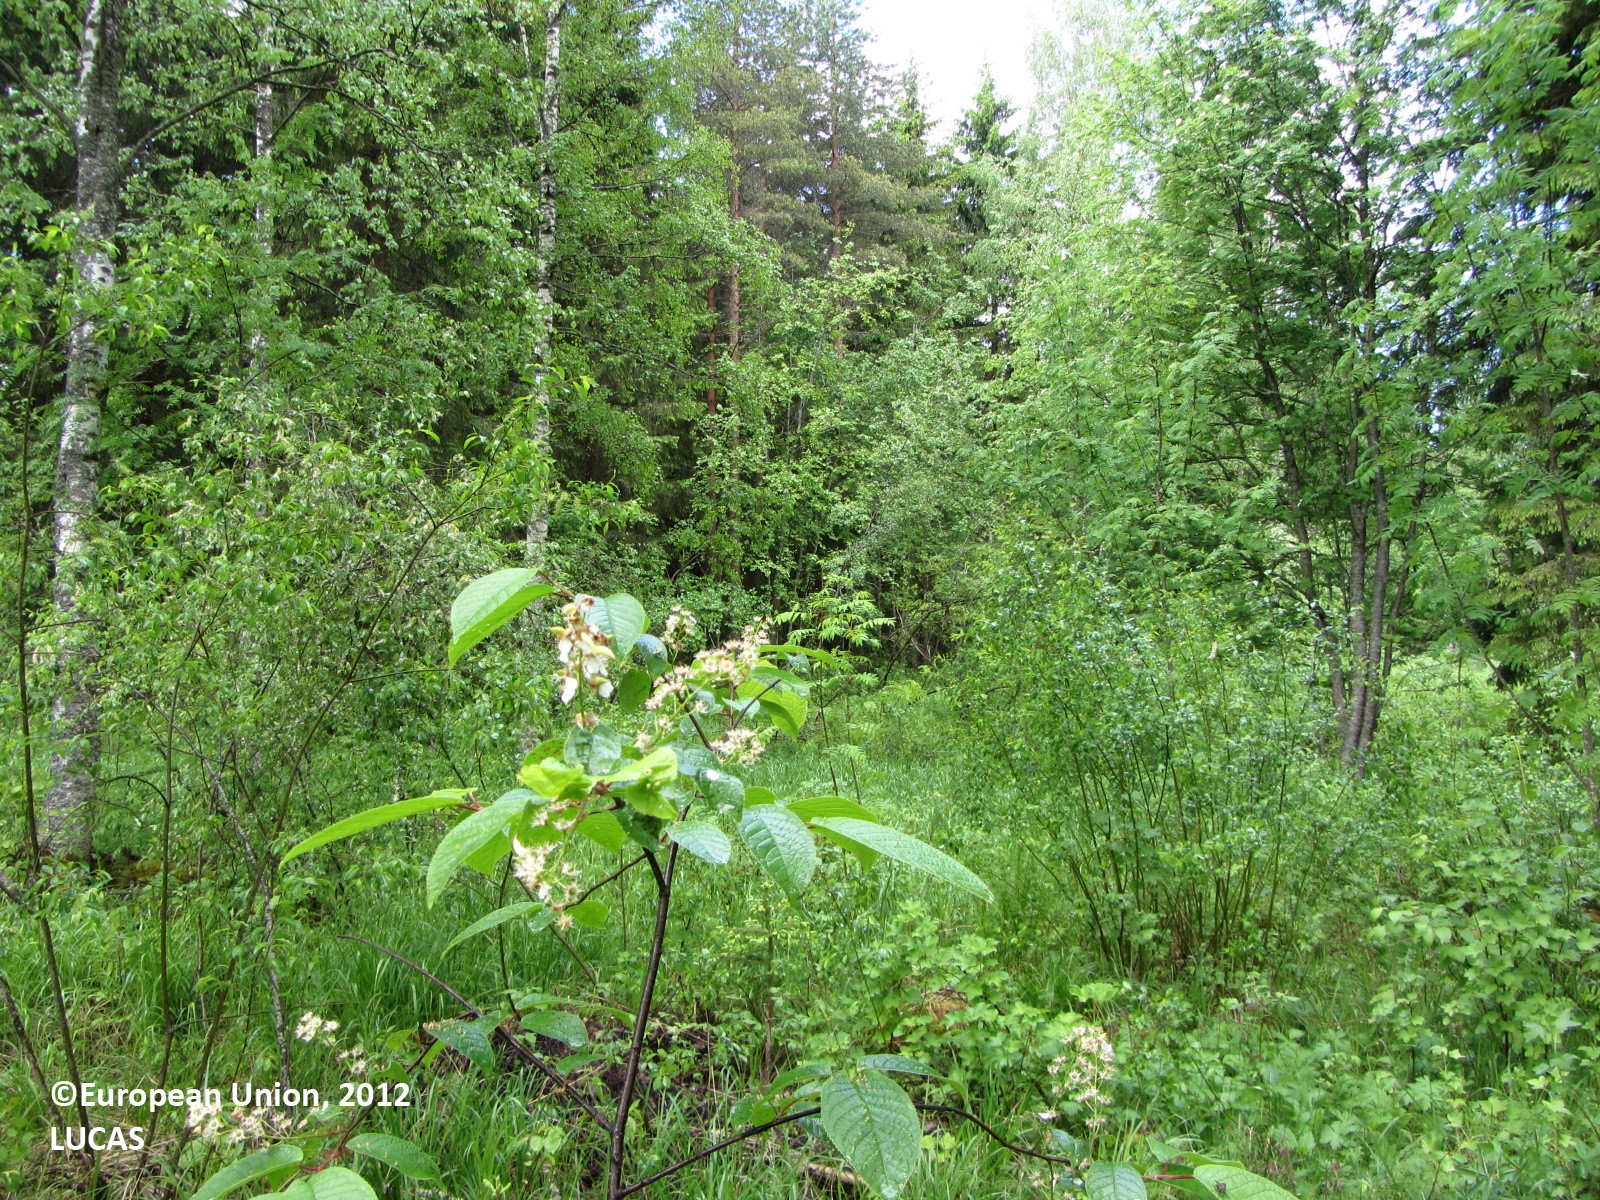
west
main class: Woodland
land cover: Broadleaved woodland
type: hemiboreal forest and nemoral coniferous forest and mixed broadleaved-coniferous forest
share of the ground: 50 - 75 %
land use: Forestry
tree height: > 5 m
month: June
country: FI
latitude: 61.8674
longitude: 24.8751
